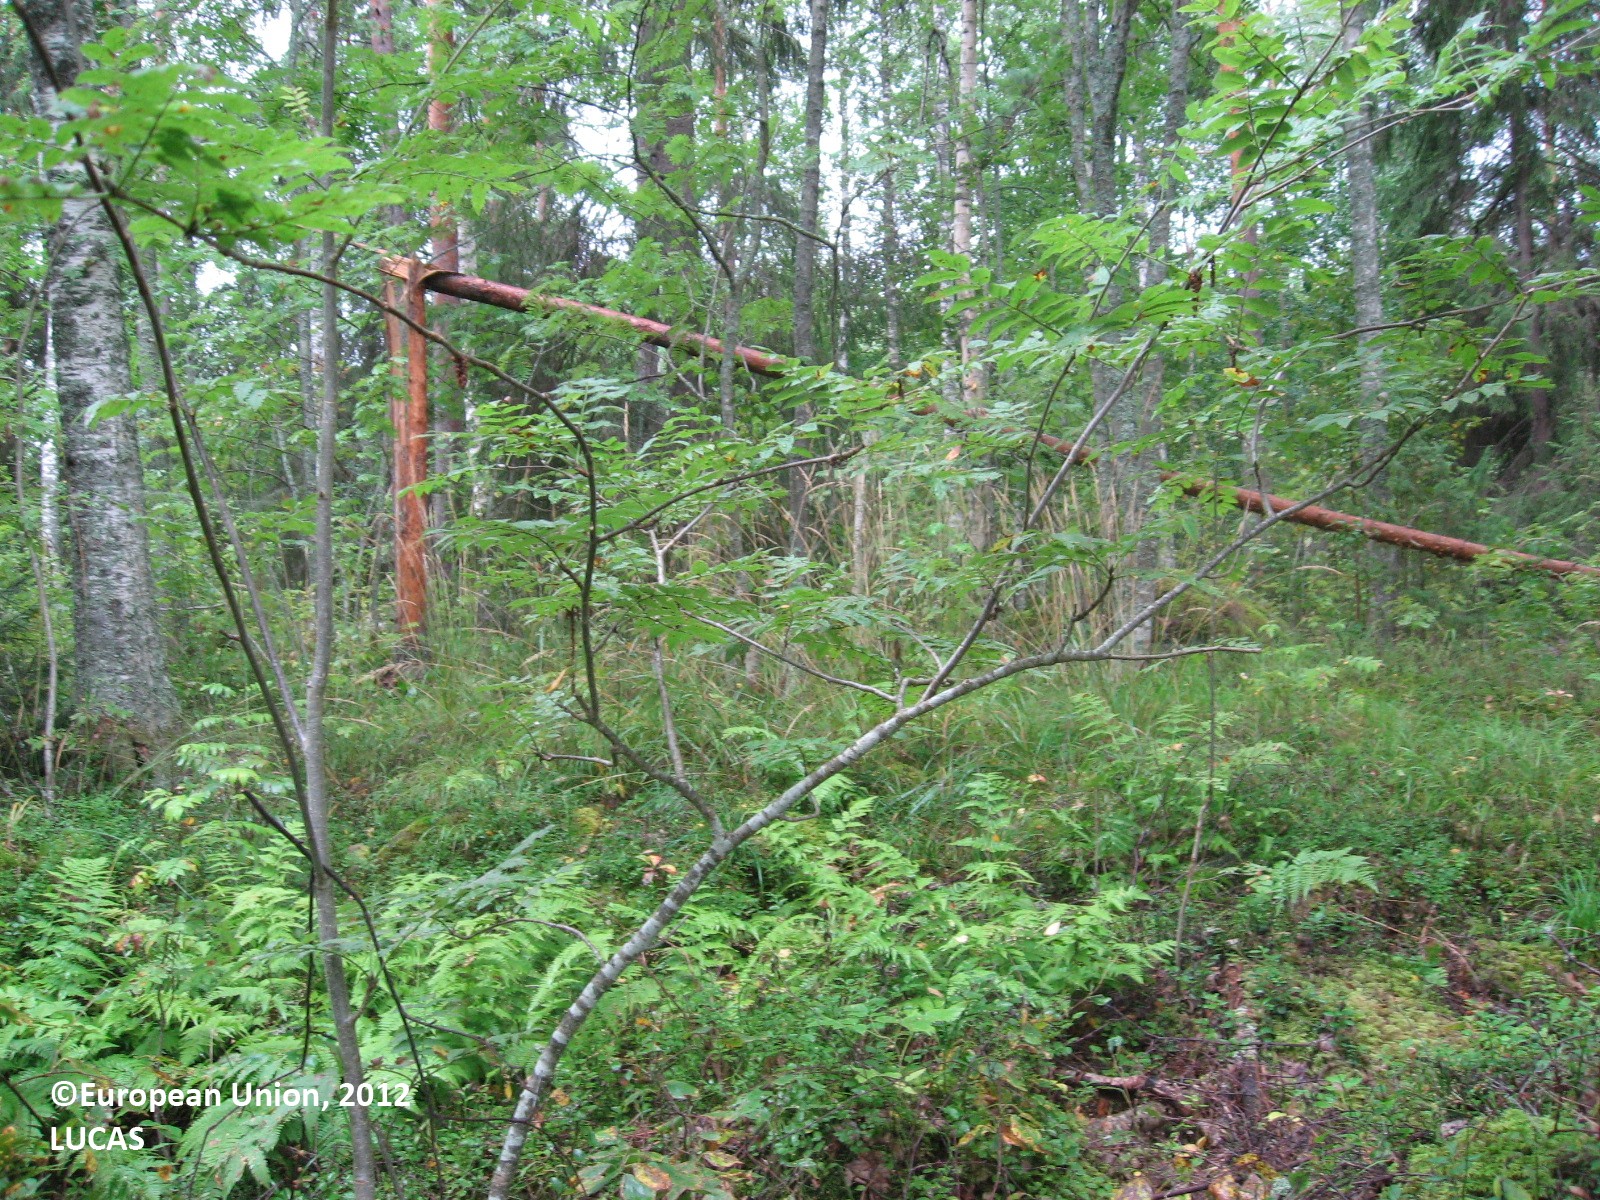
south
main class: Woodland
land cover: Other mixed woodland
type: boreal forest
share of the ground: 50 - 75 %
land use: Forestry
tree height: > 5 m
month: August
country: FI
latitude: 61.3298
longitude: 24.7351
